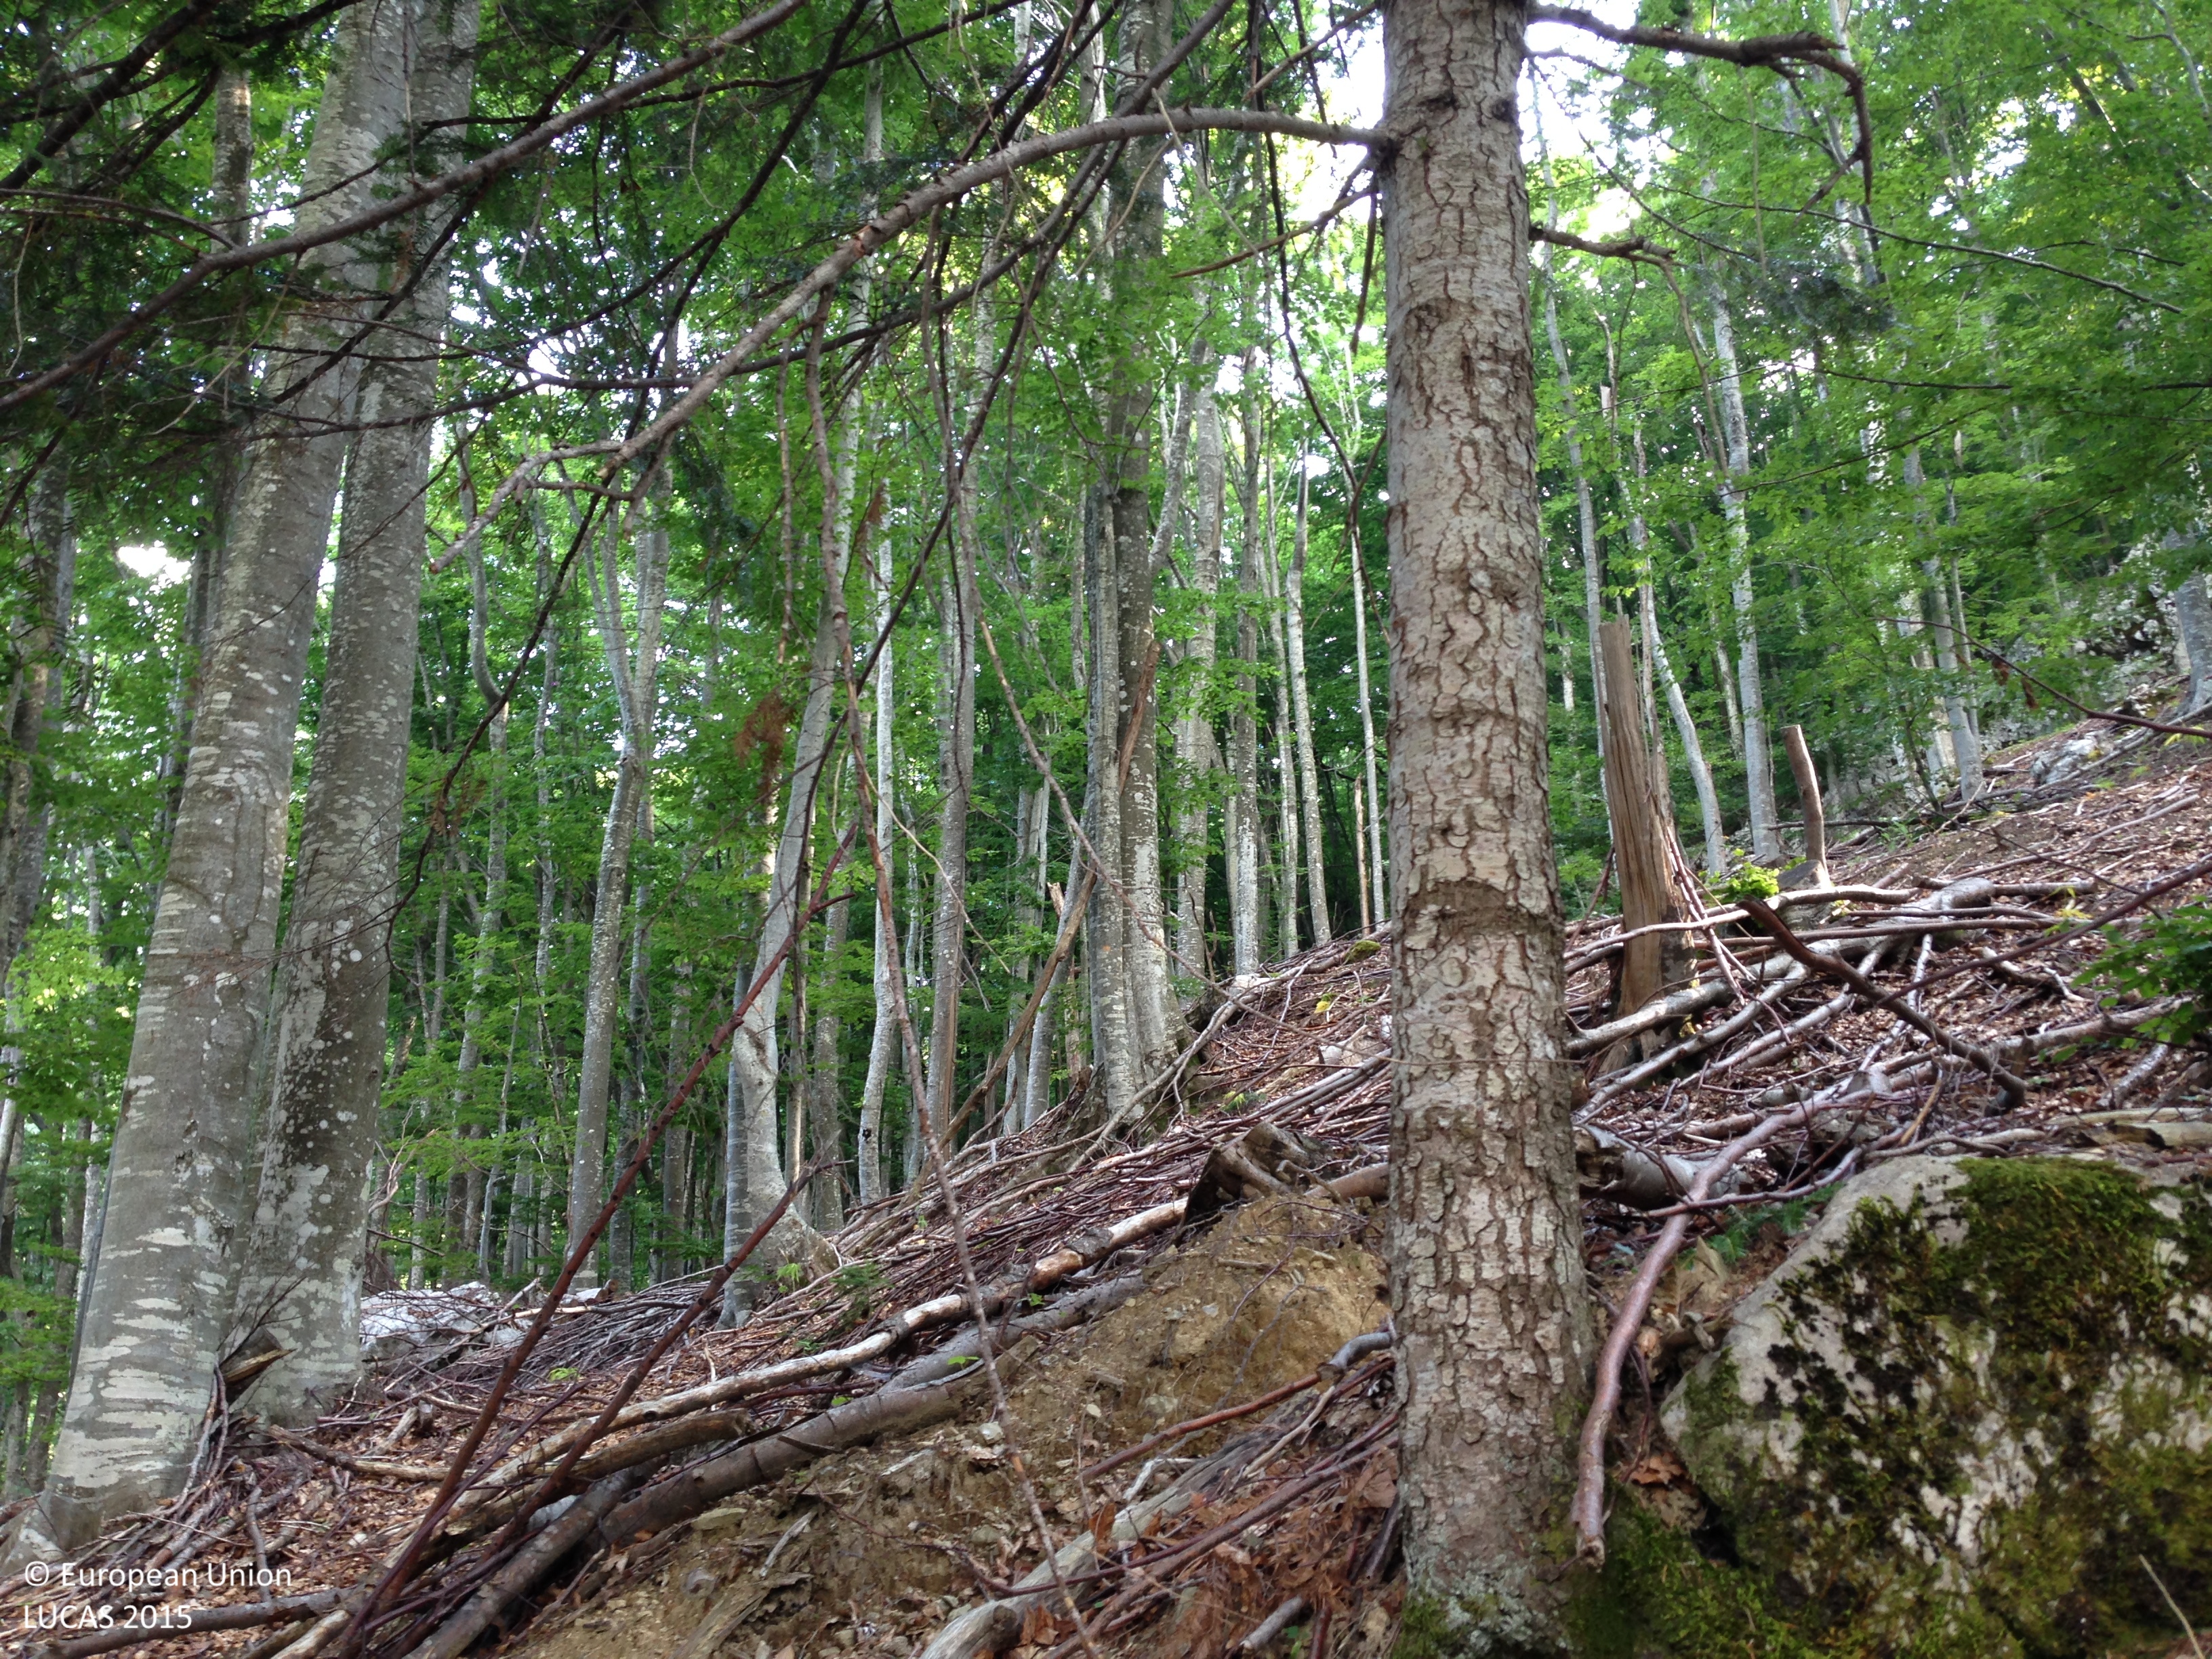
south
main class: Woodland
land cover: Other mixed woodland
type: mountainous beech forest
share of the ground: > 75 %
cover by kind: broadleaved forest trees 60 %, coniferous forest trees 20 %, lichens and mosses 10 %, shrubs 5 %, unconsolidated bare surface 5 %
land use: Forestry
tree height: > 5 m
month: July
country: HR
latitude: 44.6203
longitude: 15.1480
